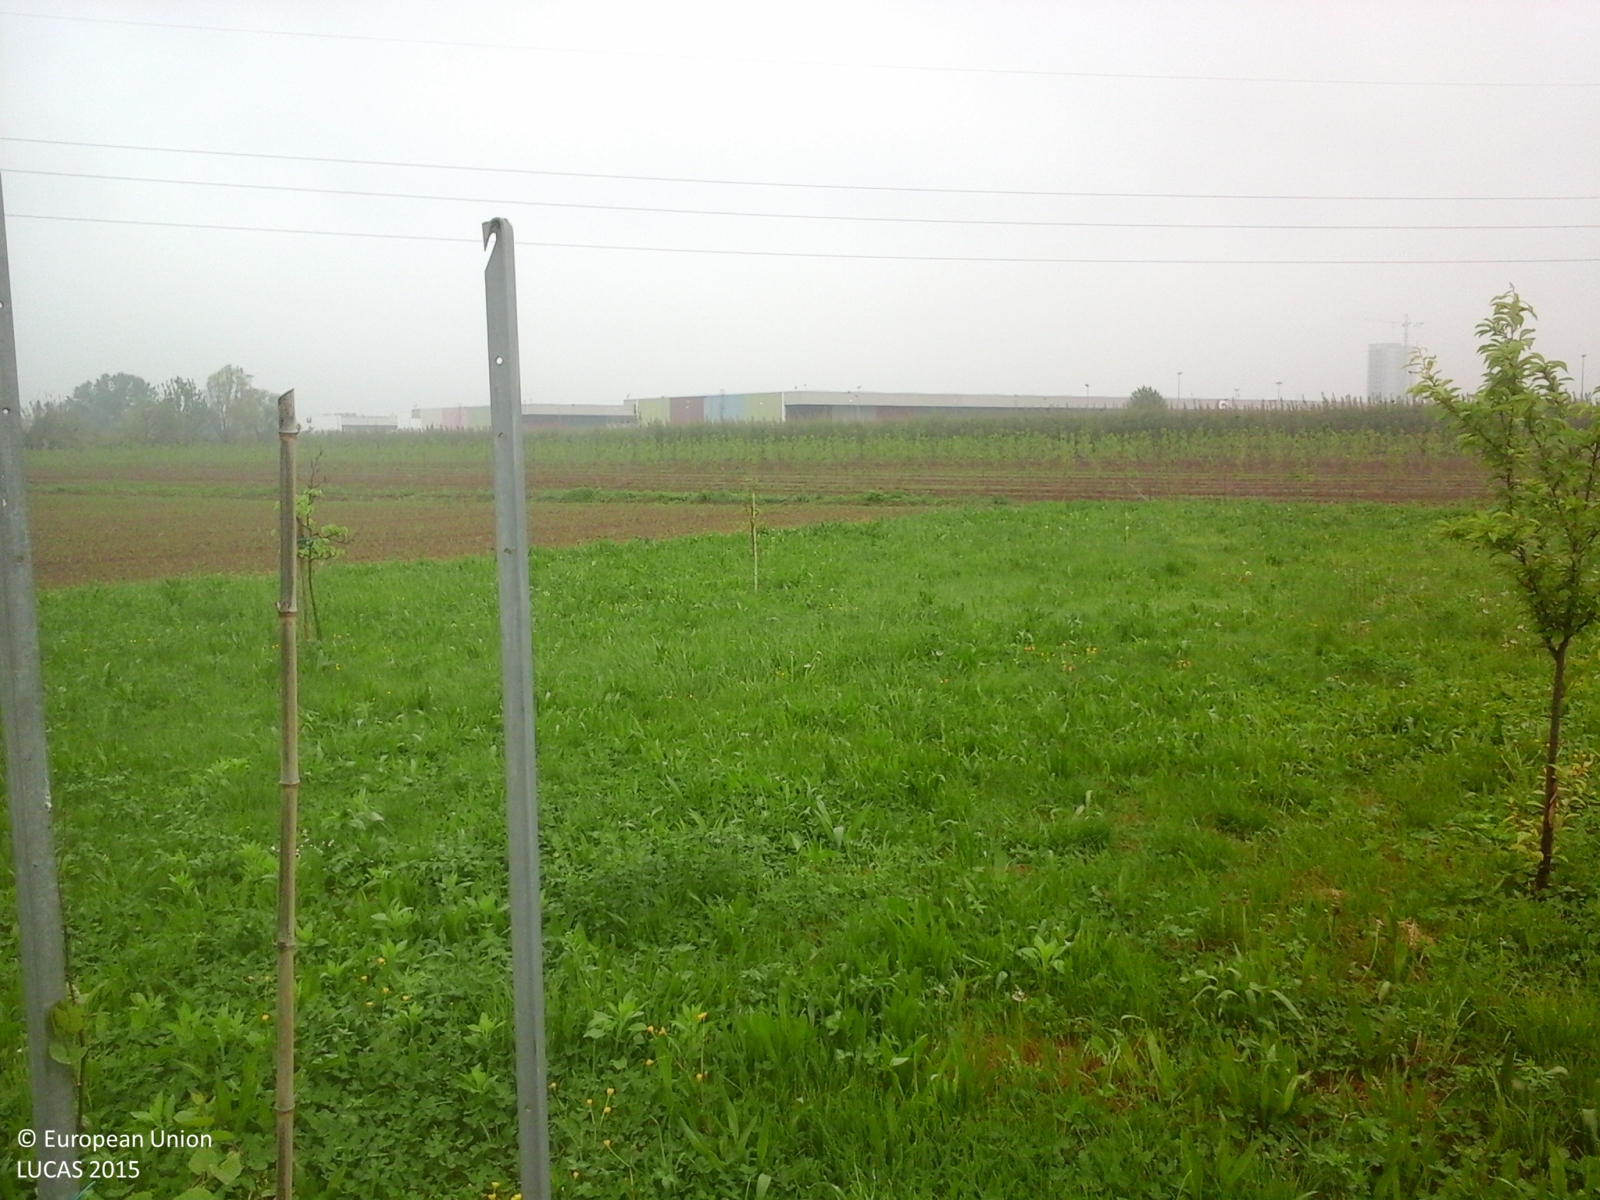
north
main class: Cropland
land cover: Pear fruit
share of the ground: 10 - 25 %
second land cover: Spontaneously vegetated surfaces
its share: > 75 %
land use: Kitchen garden
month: April
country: IT
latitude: 45.3787
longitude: 11.9251
